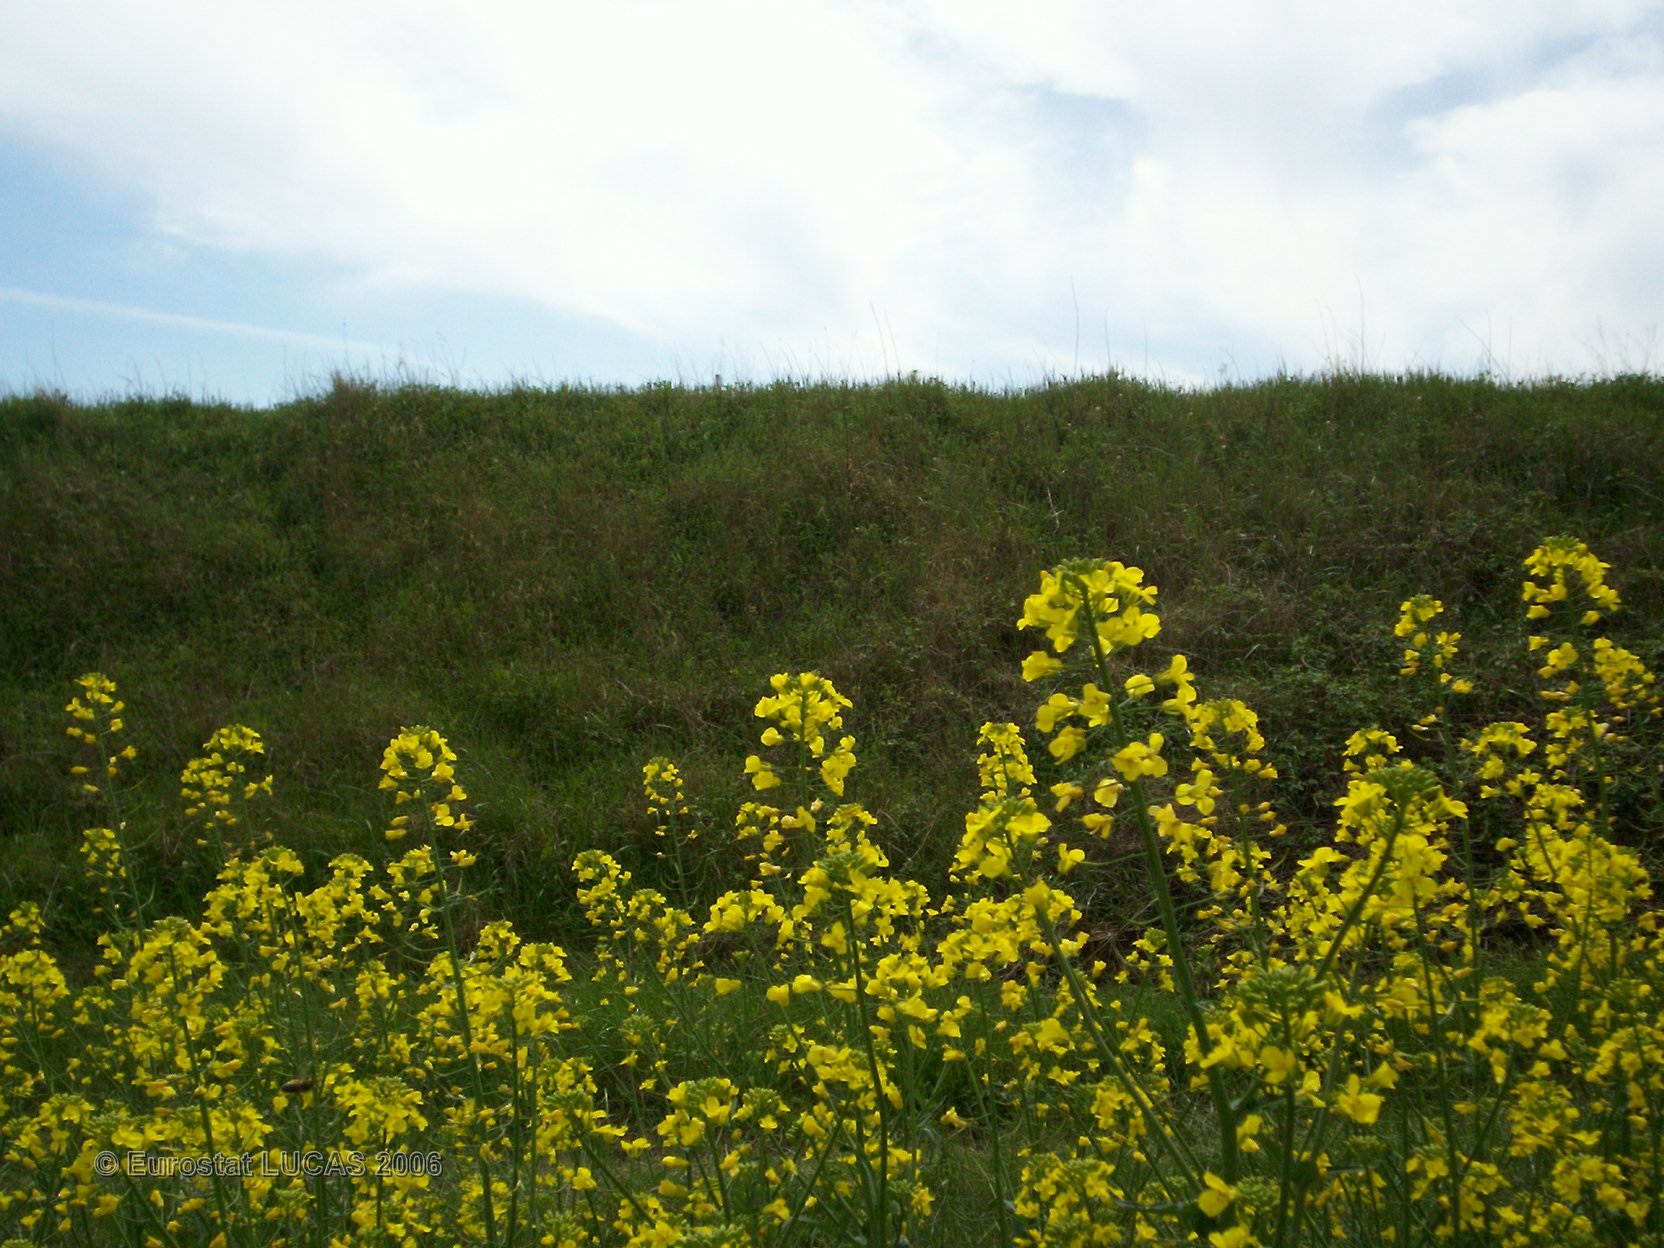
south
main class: Cropland
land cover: Rape and turnip rape
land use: Agriculture (excluding fallow land and kitchen gardens)
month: April
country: FR
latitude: 43.7372
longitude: 5.2786
